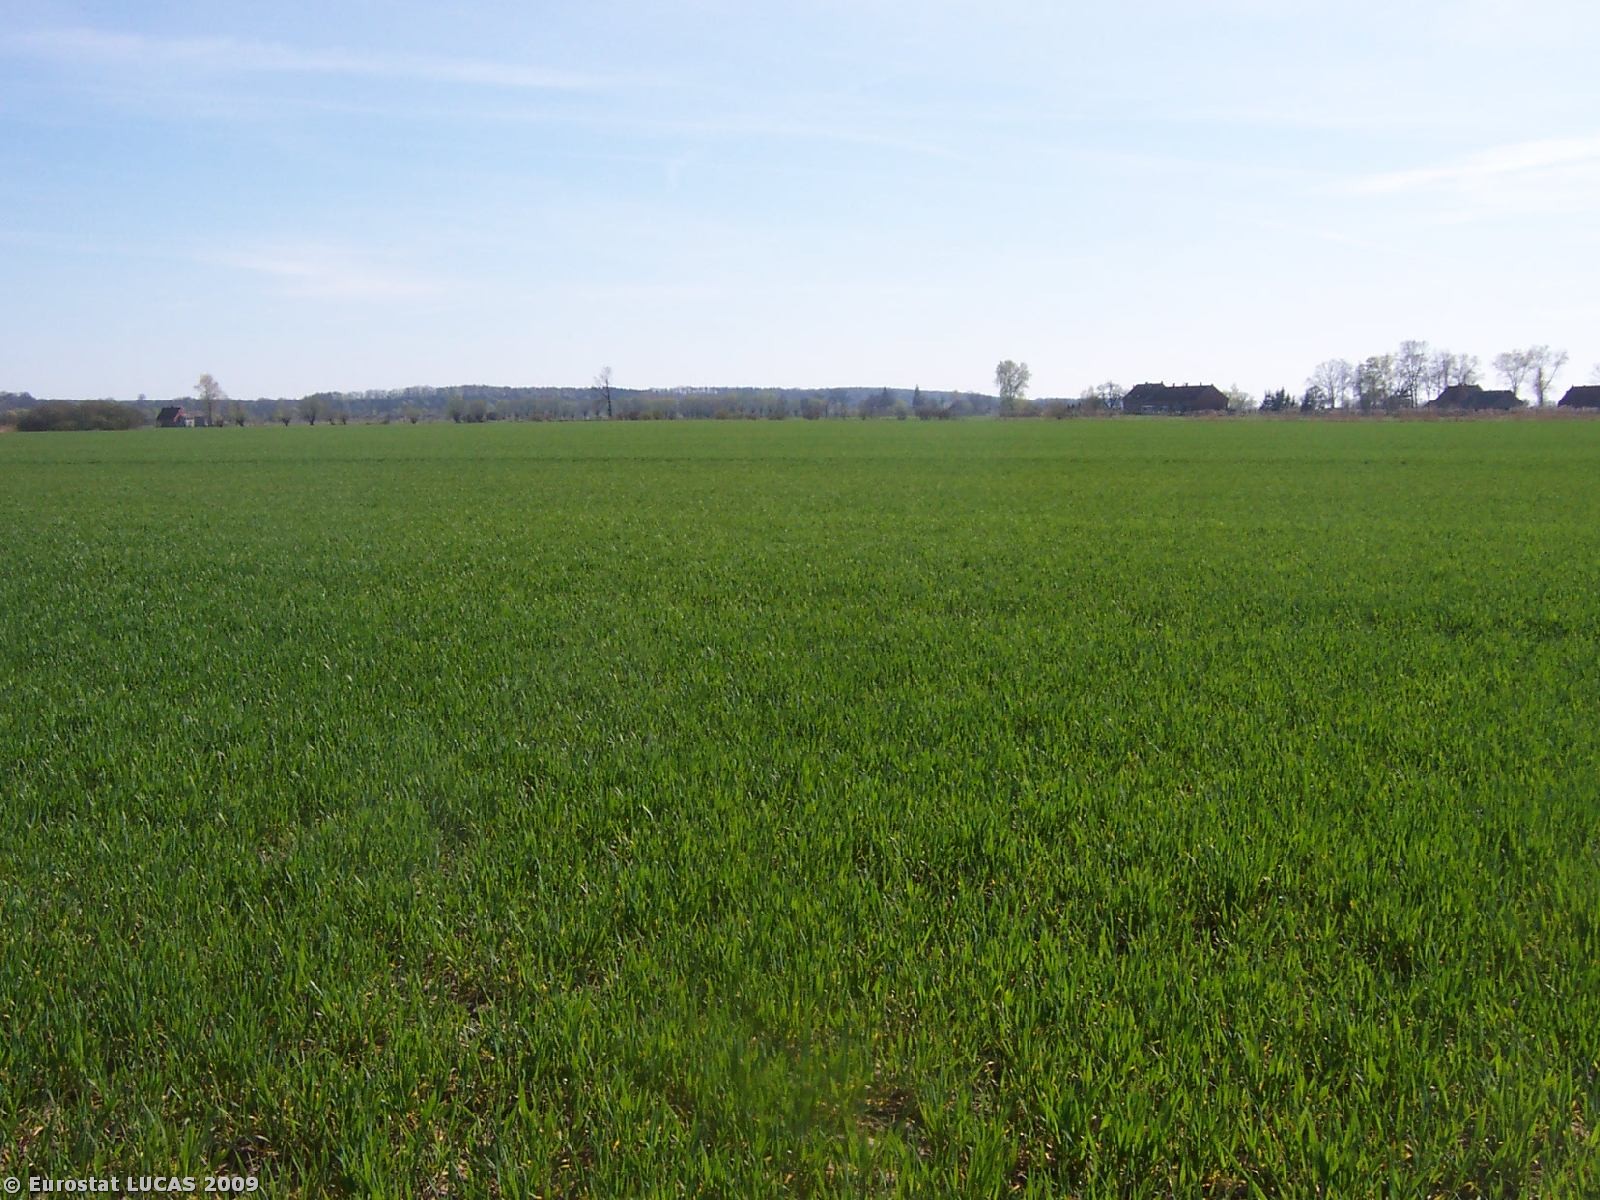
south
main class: Cropland
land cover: Common wheat
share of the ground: 25 - 50 %
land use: Agriculture (excluding fallow land and kitchen gardens)
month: April
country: PL
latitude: 54.0109
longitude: 18.9480
